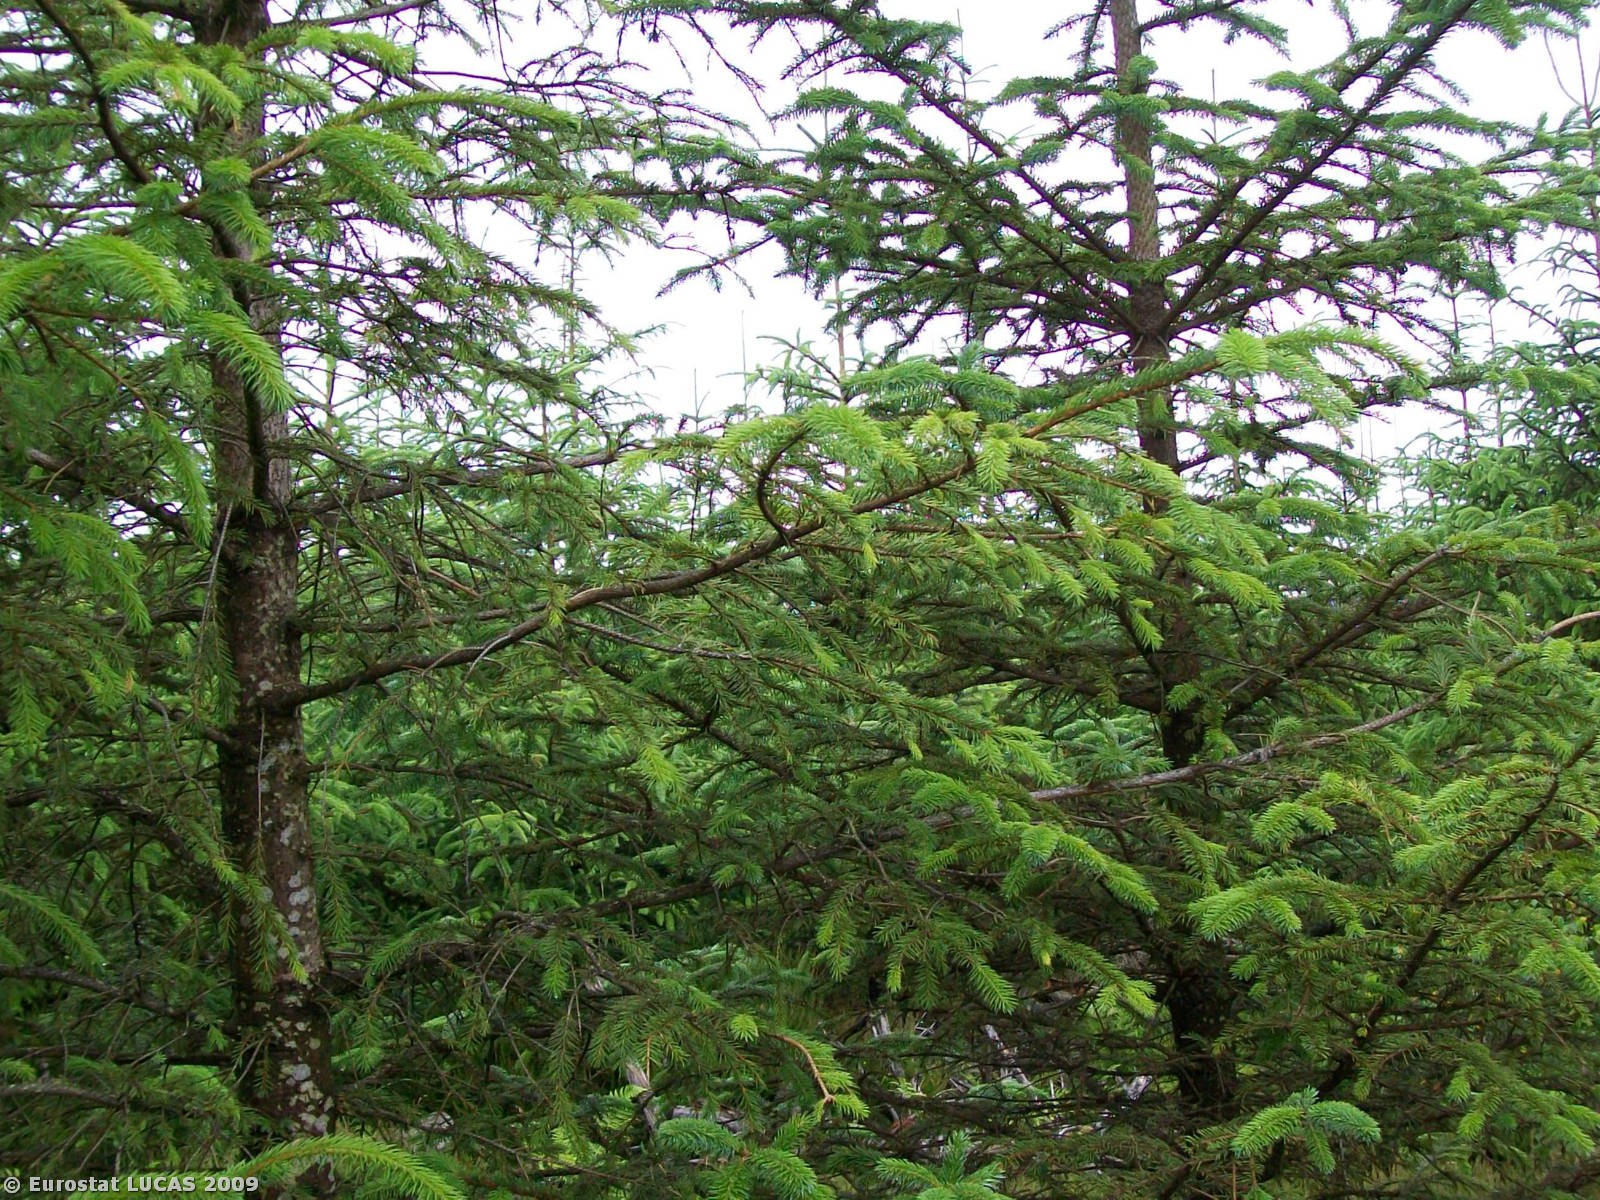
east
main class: Woodland
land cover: Coniferous woodland
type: plantations and self-sown exotic forest
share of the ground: > 75 %
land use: Forestry
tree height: > 5 m
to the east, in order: Coniferous woodland; Ditches and canals; Coniferous woodland; Ditches and canals; Coniferous woodland; Ditches and canals; Coniferous woodland
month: July
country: GB
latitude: 55.1261
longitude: -3.9685
